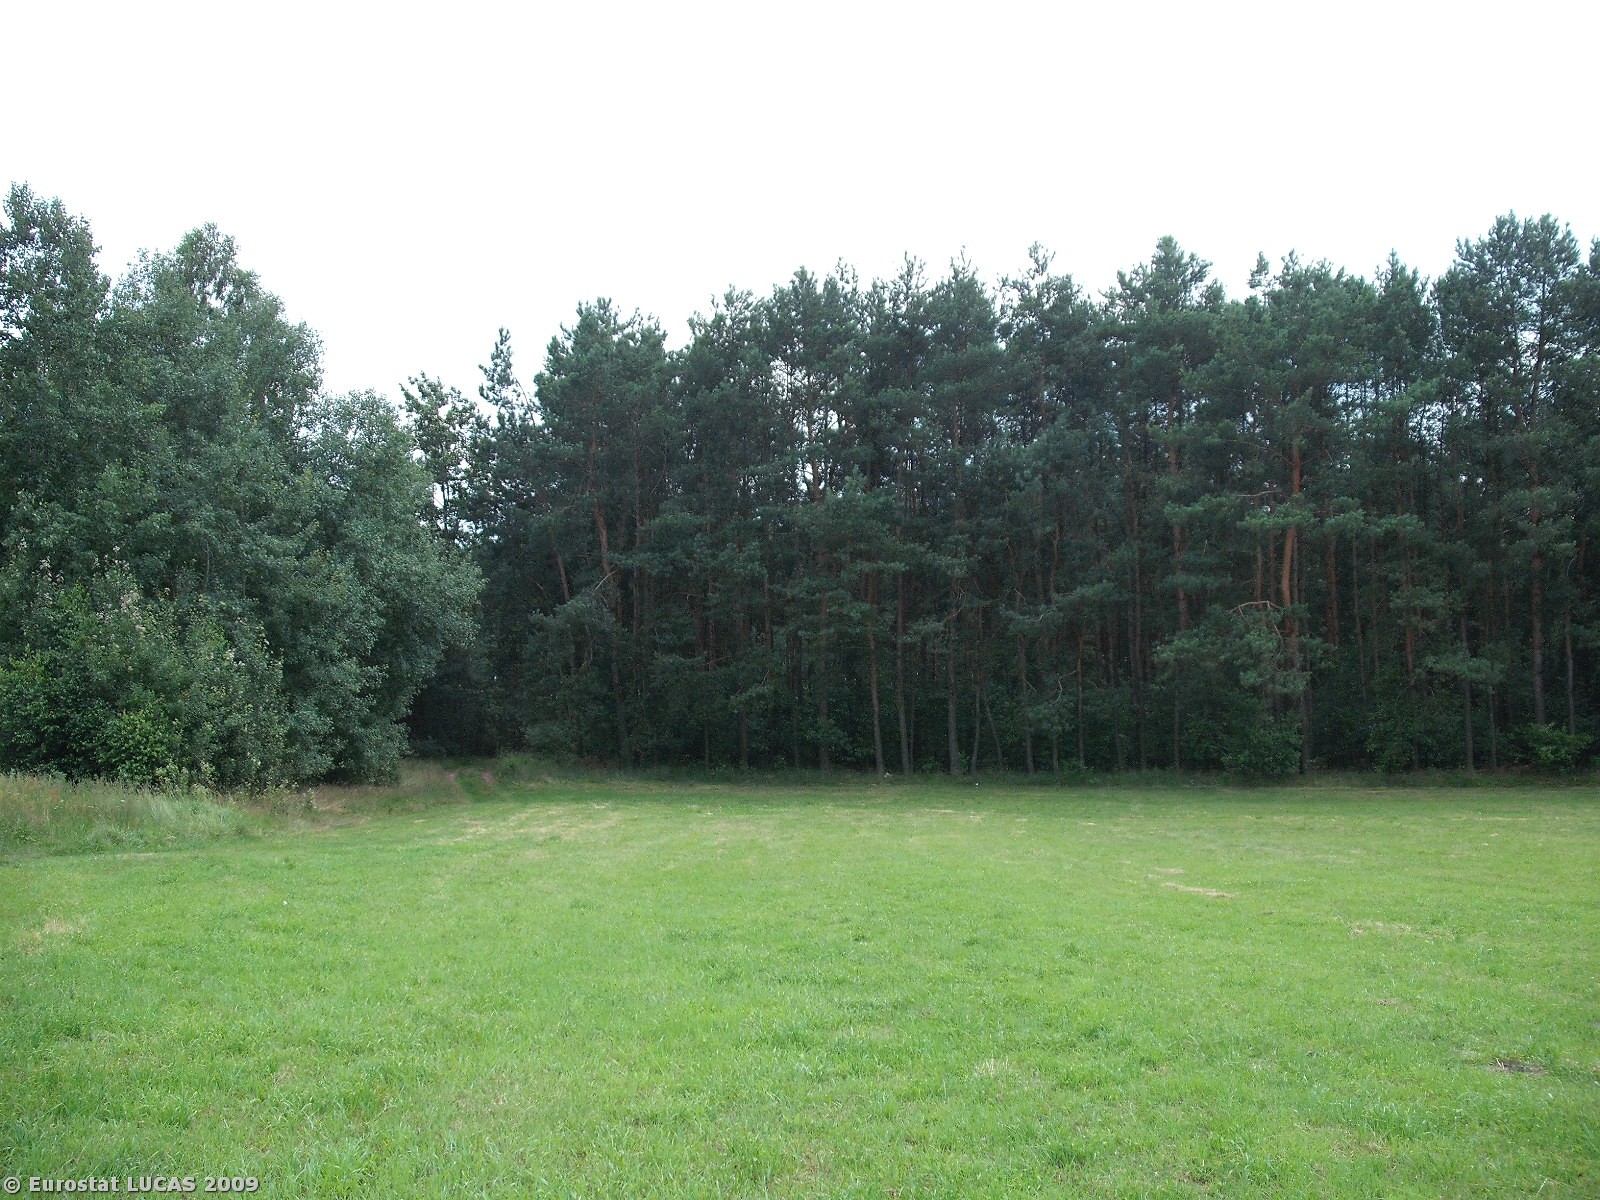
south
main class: Grassland
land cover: Grassland without tree/shrub cover
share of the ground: > 75 %
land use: Agriculture (excluding fallow land and kitchen gardens)
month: July
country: PL
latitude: 51.5487
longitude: 21.0775
